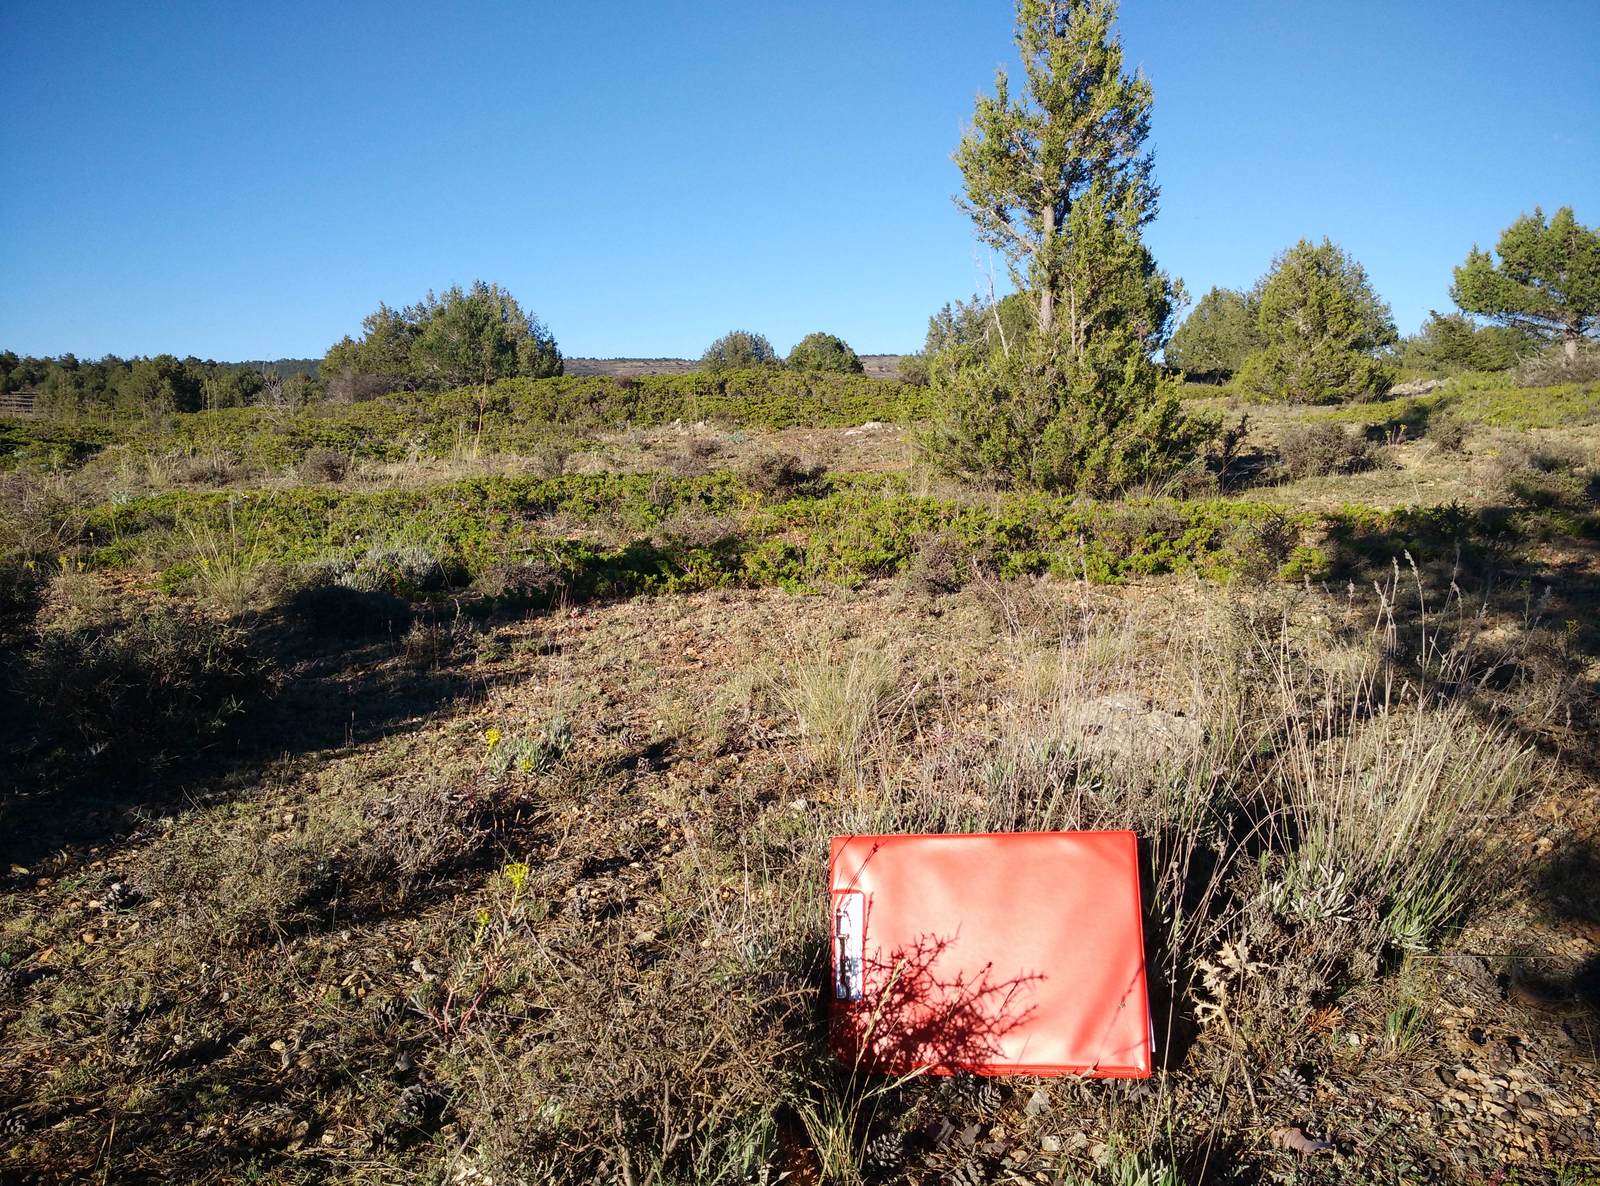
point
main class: Shrubland
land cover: Shrubland with sparse tree cover
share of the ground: 50 - 75 %
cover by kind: shrubs 50 %, unconsolidated bare surface 40 %, coniferous forest trees 5 %, herbaceous plants 5 %
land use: Semi-natural and natural areas not in use
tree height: > 5 m
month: June
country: ES
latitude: 40.6320
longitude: -1.7828
